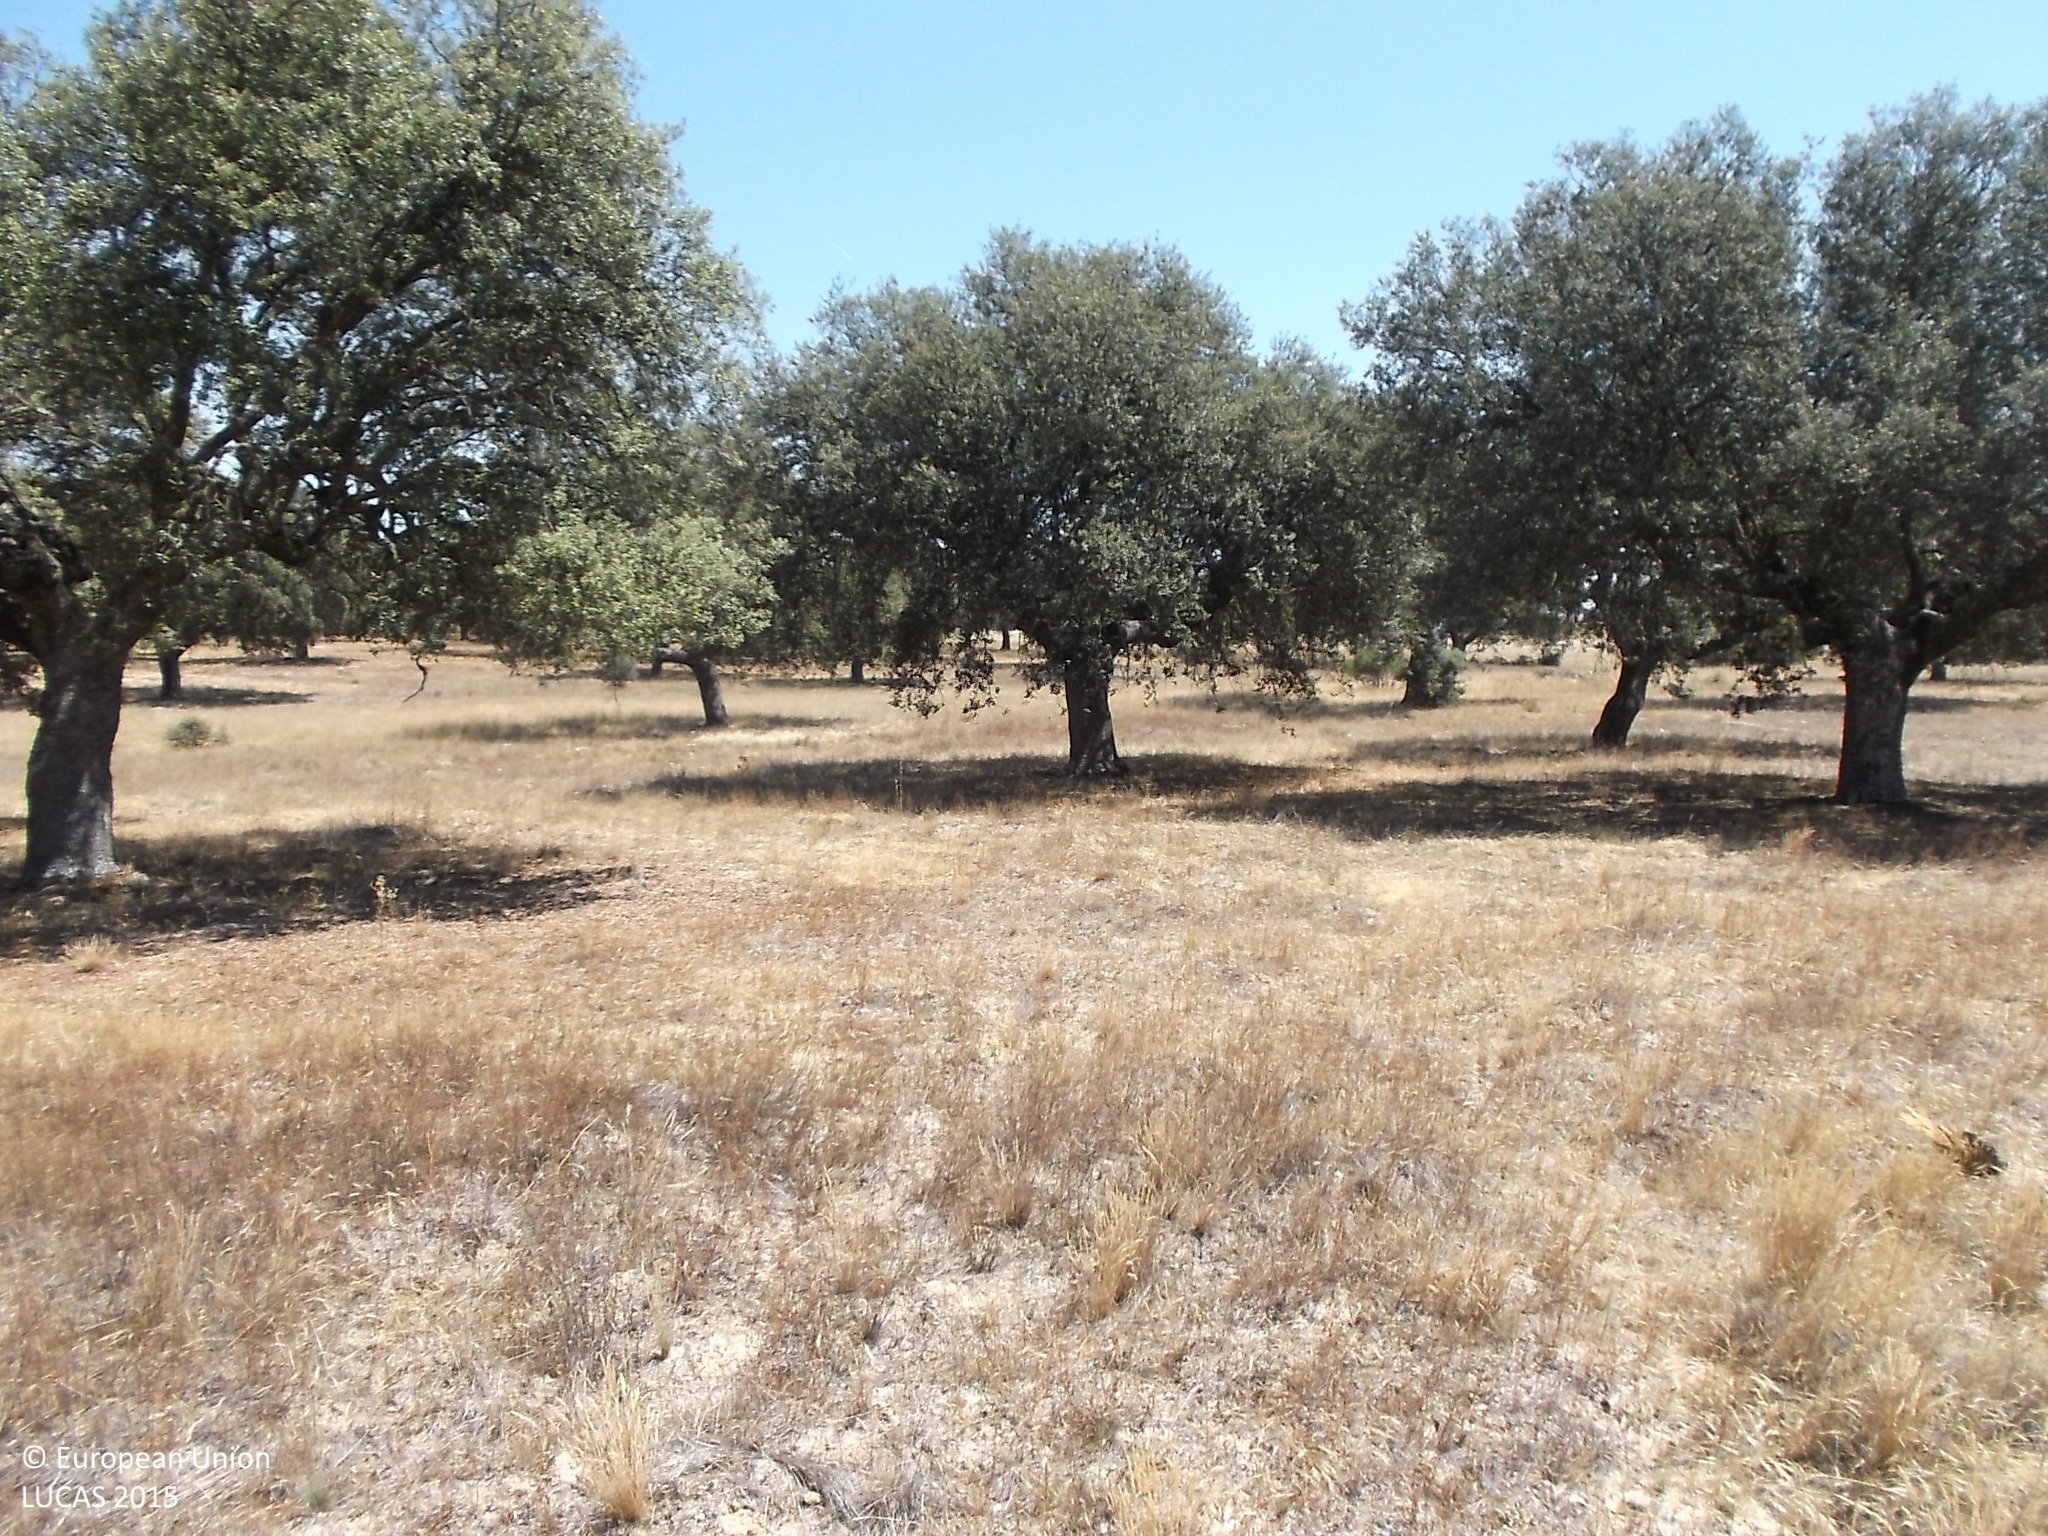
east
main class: Woodland
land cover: Broadleaved woodland
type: broadleaved evergreen forest
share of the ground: 50 - 75 %
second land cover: Grassland without tree/shrub cover
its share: 50 - 75 %
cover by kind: broadleaved forest trees 50 %, herbaceous plants 50 %
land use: Forestry
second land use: Agriculture (excluding fallow land and kitchen gardens)
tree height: < 5 m
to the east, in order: Broadleaved woodland; Grassland without tree/shrub cover; Tracks; Grassland with sparse tree/shrub cover; Mixed cereals for fodder
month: July
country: ES
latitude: 41.3670
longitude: -5.8067
